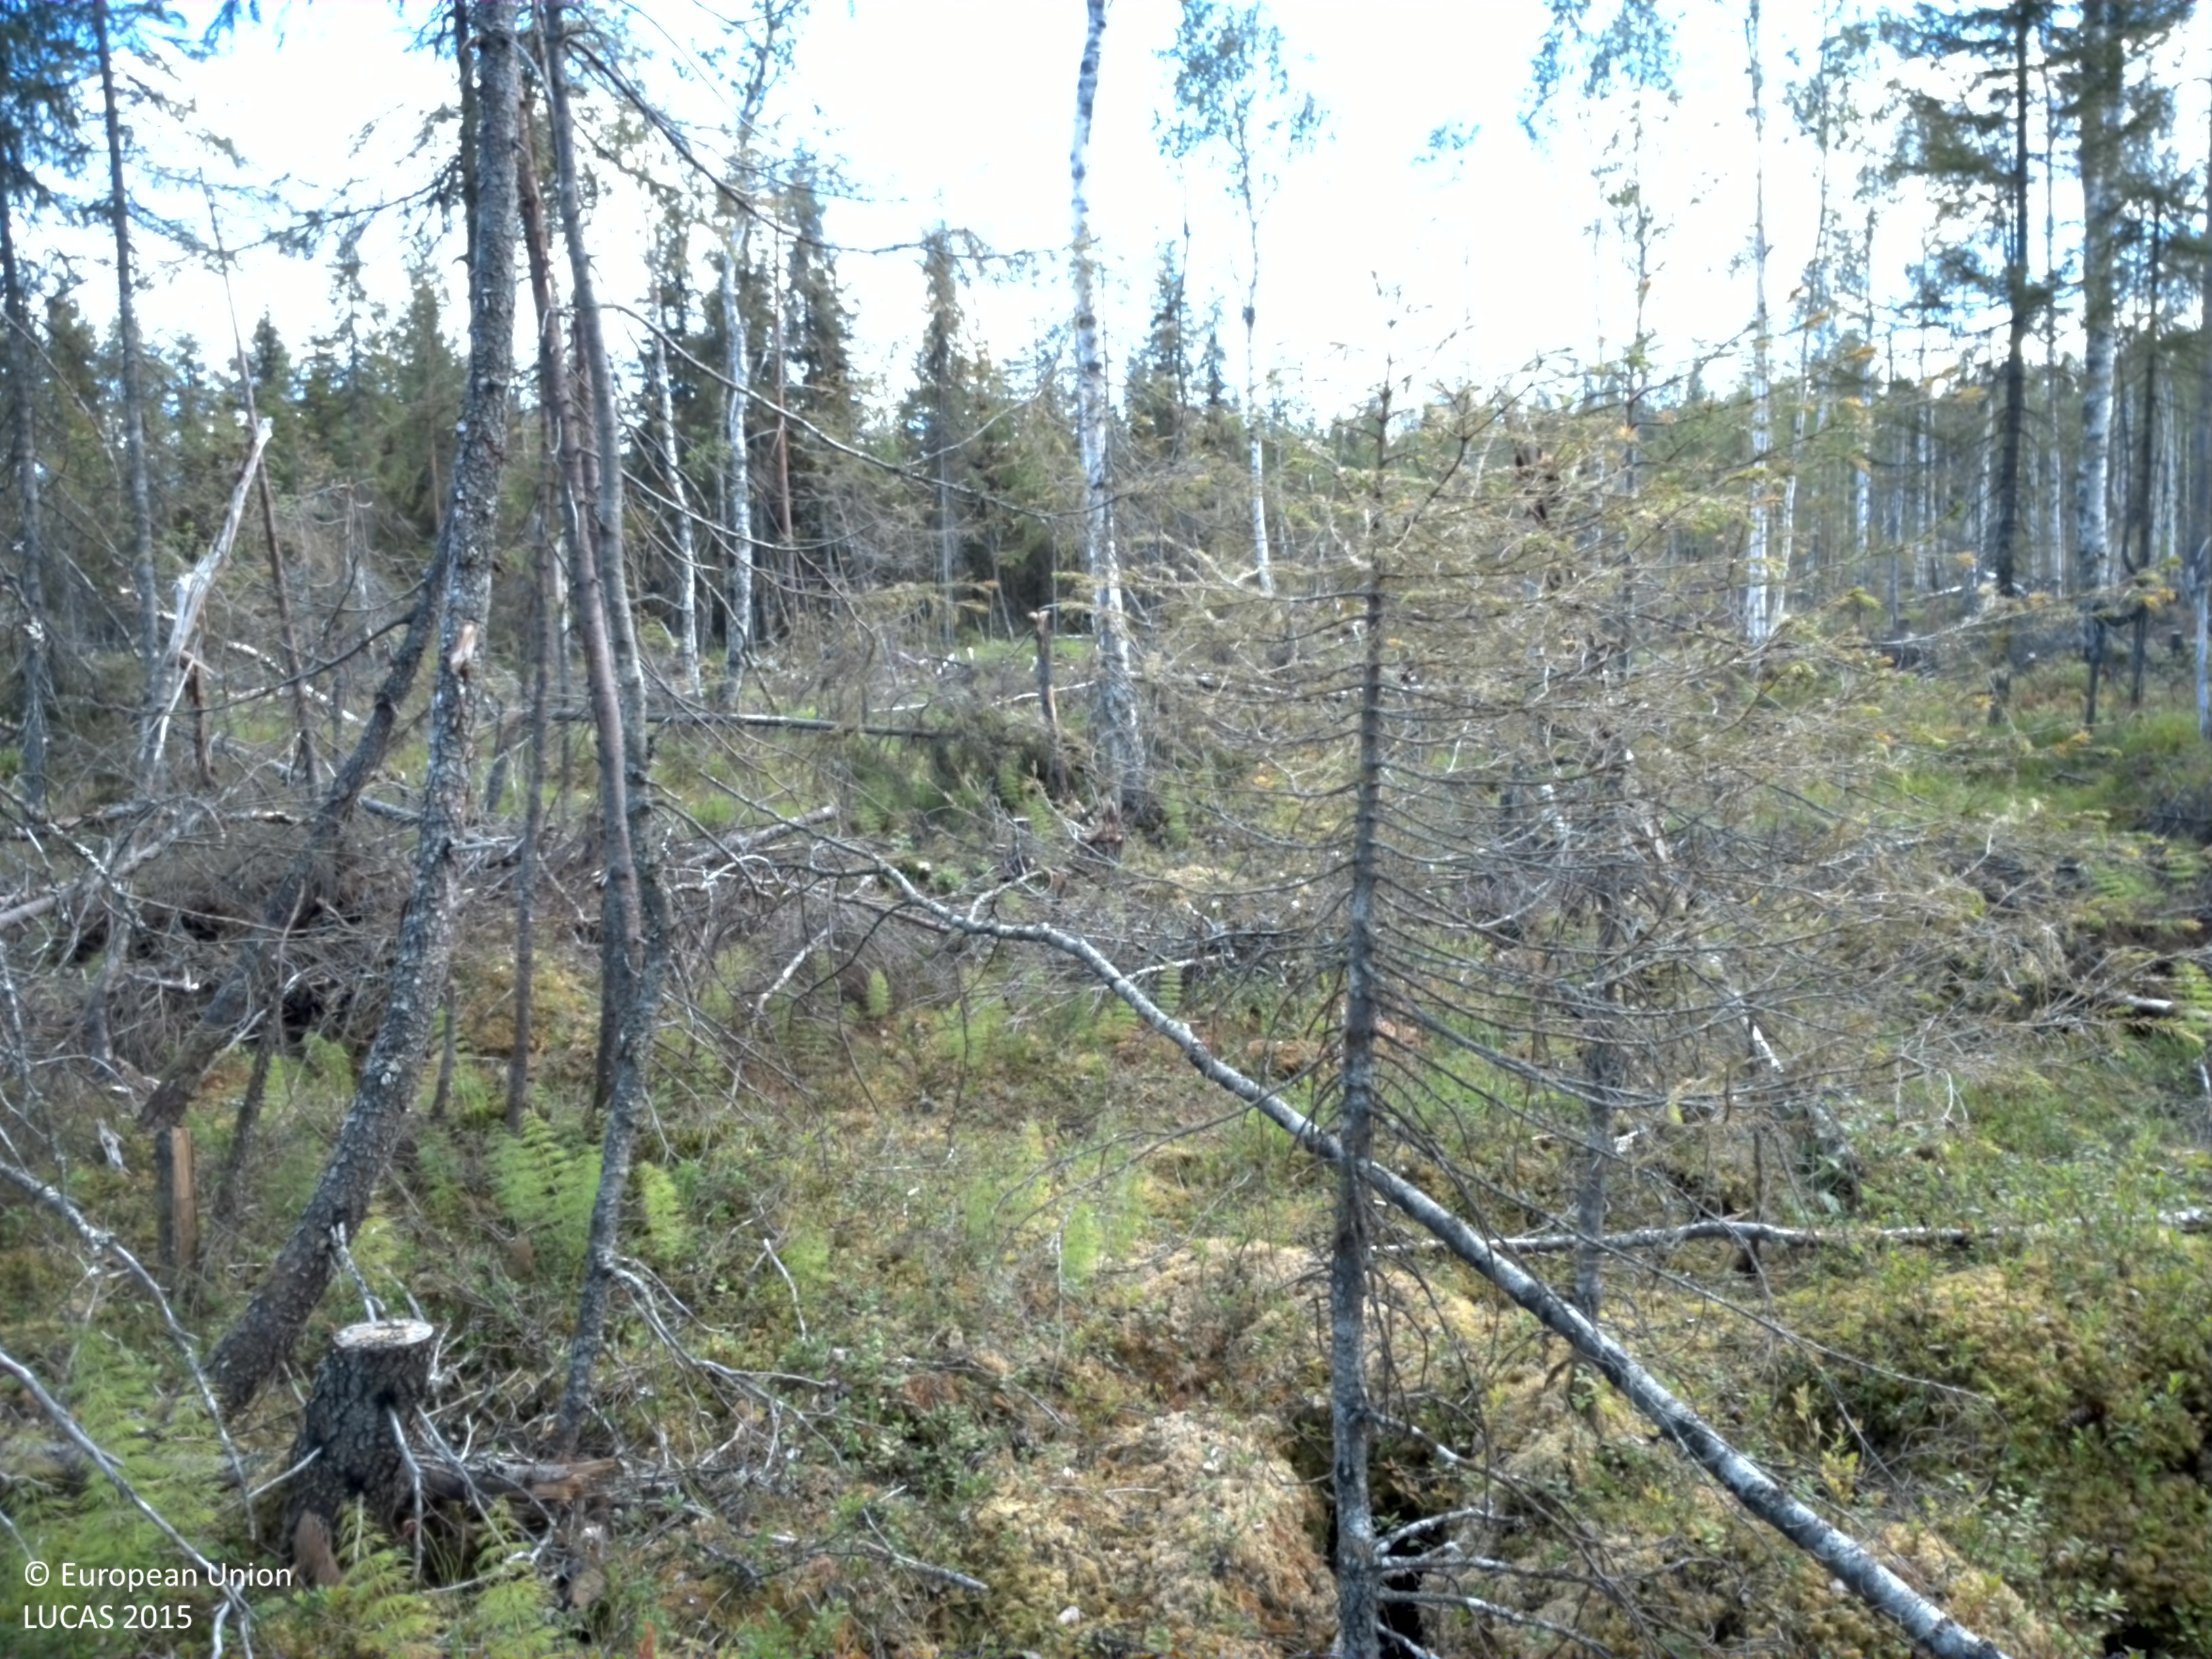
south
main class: Woodland
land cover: Broadleaved woodland
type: boreal forest
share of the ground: 10 - 25 %
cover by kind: shrubs 65 %, broadleaved forest trees 20 %, lichens and mosses 10 %, coniferous forest trees 5 %
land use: Forestry
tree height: > 5 m
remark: Clear cut
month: August
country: SE
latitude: 66.2376
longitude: 22.6764
